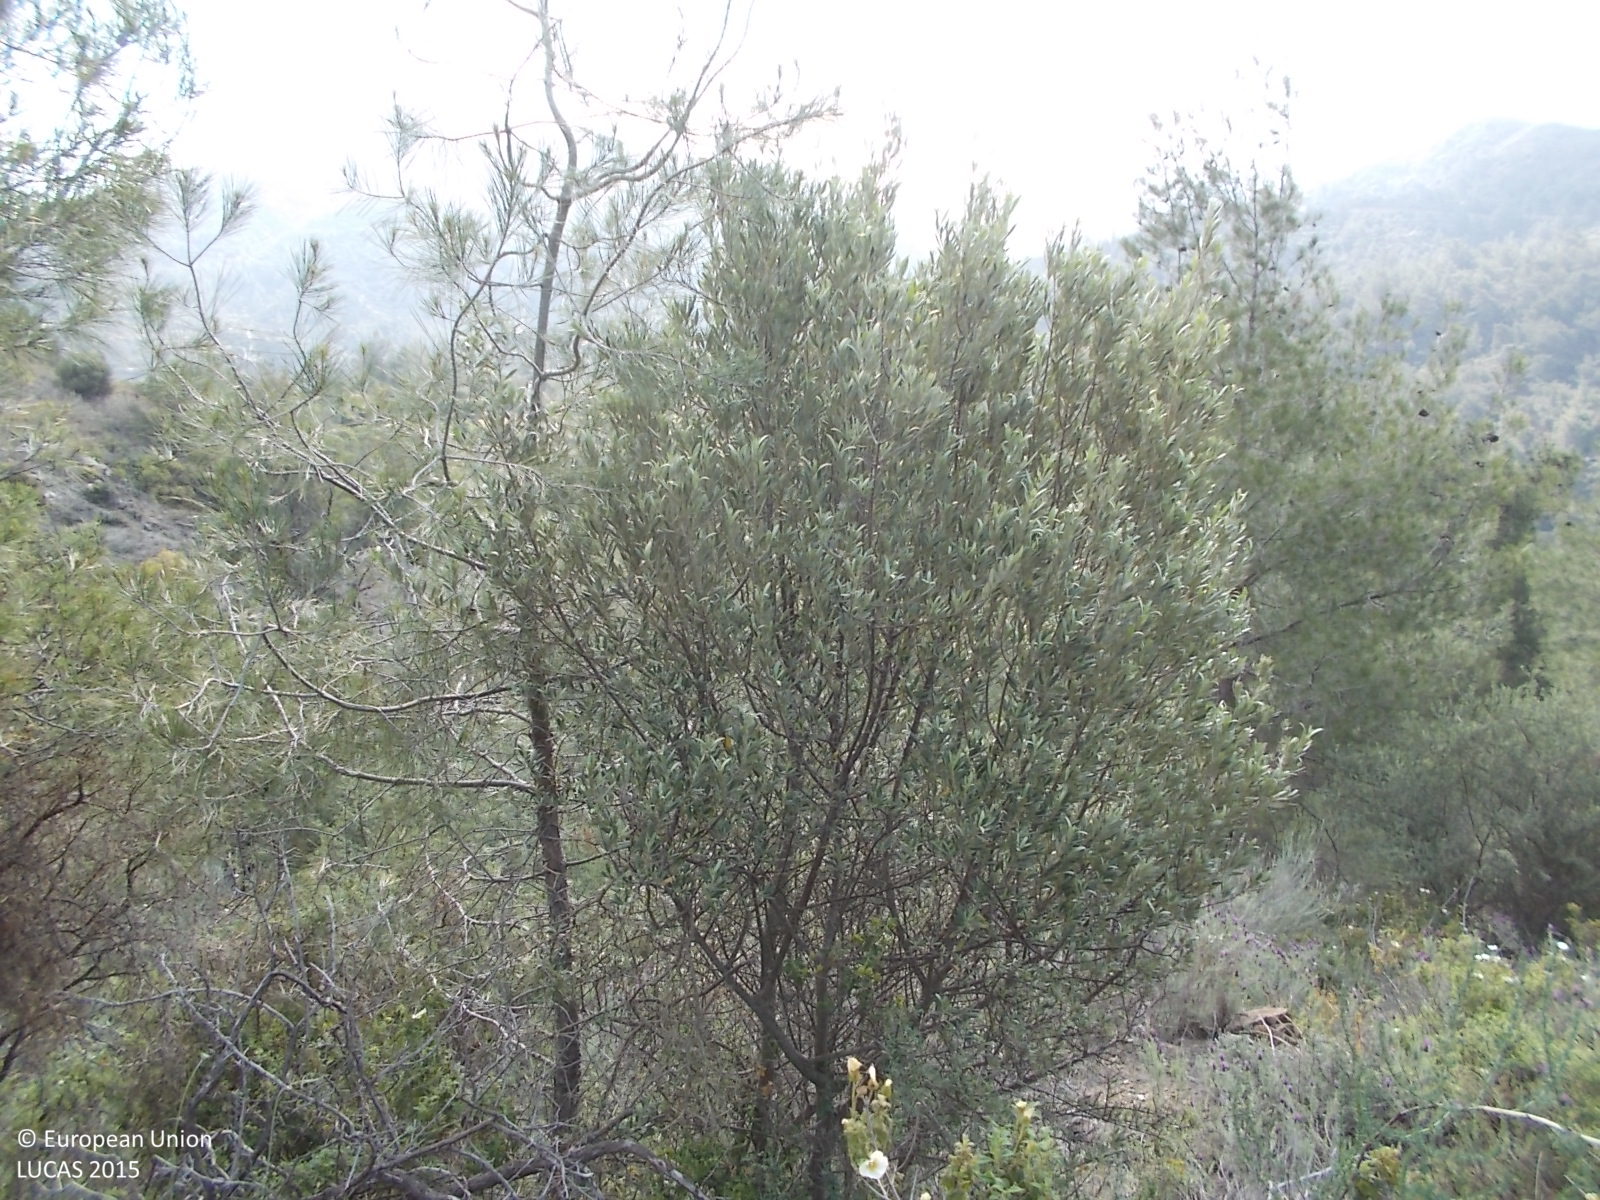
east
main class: Woodland
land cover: Pine dominated coniferous woodland
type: coniferous forest of the mediterranean region
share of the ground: 50 - 75 %
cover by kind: coniferous forest trees 45 %, shrubs 35 %, broadleaved forest trees 10 %, unconsolidated bare surface 10 %
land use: Semi-natural and natural areas not in use
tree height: > 5 m
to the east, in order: Pine dominated coniferous woodland; Shrubland with sparse tree cover; Pine dominated mixed woodland; Pine dominated coniferous woodland; Tracks; Pine dominated mixed woodland; Tracks
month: April
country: CY
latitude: 34.8194
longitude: 33.1204
